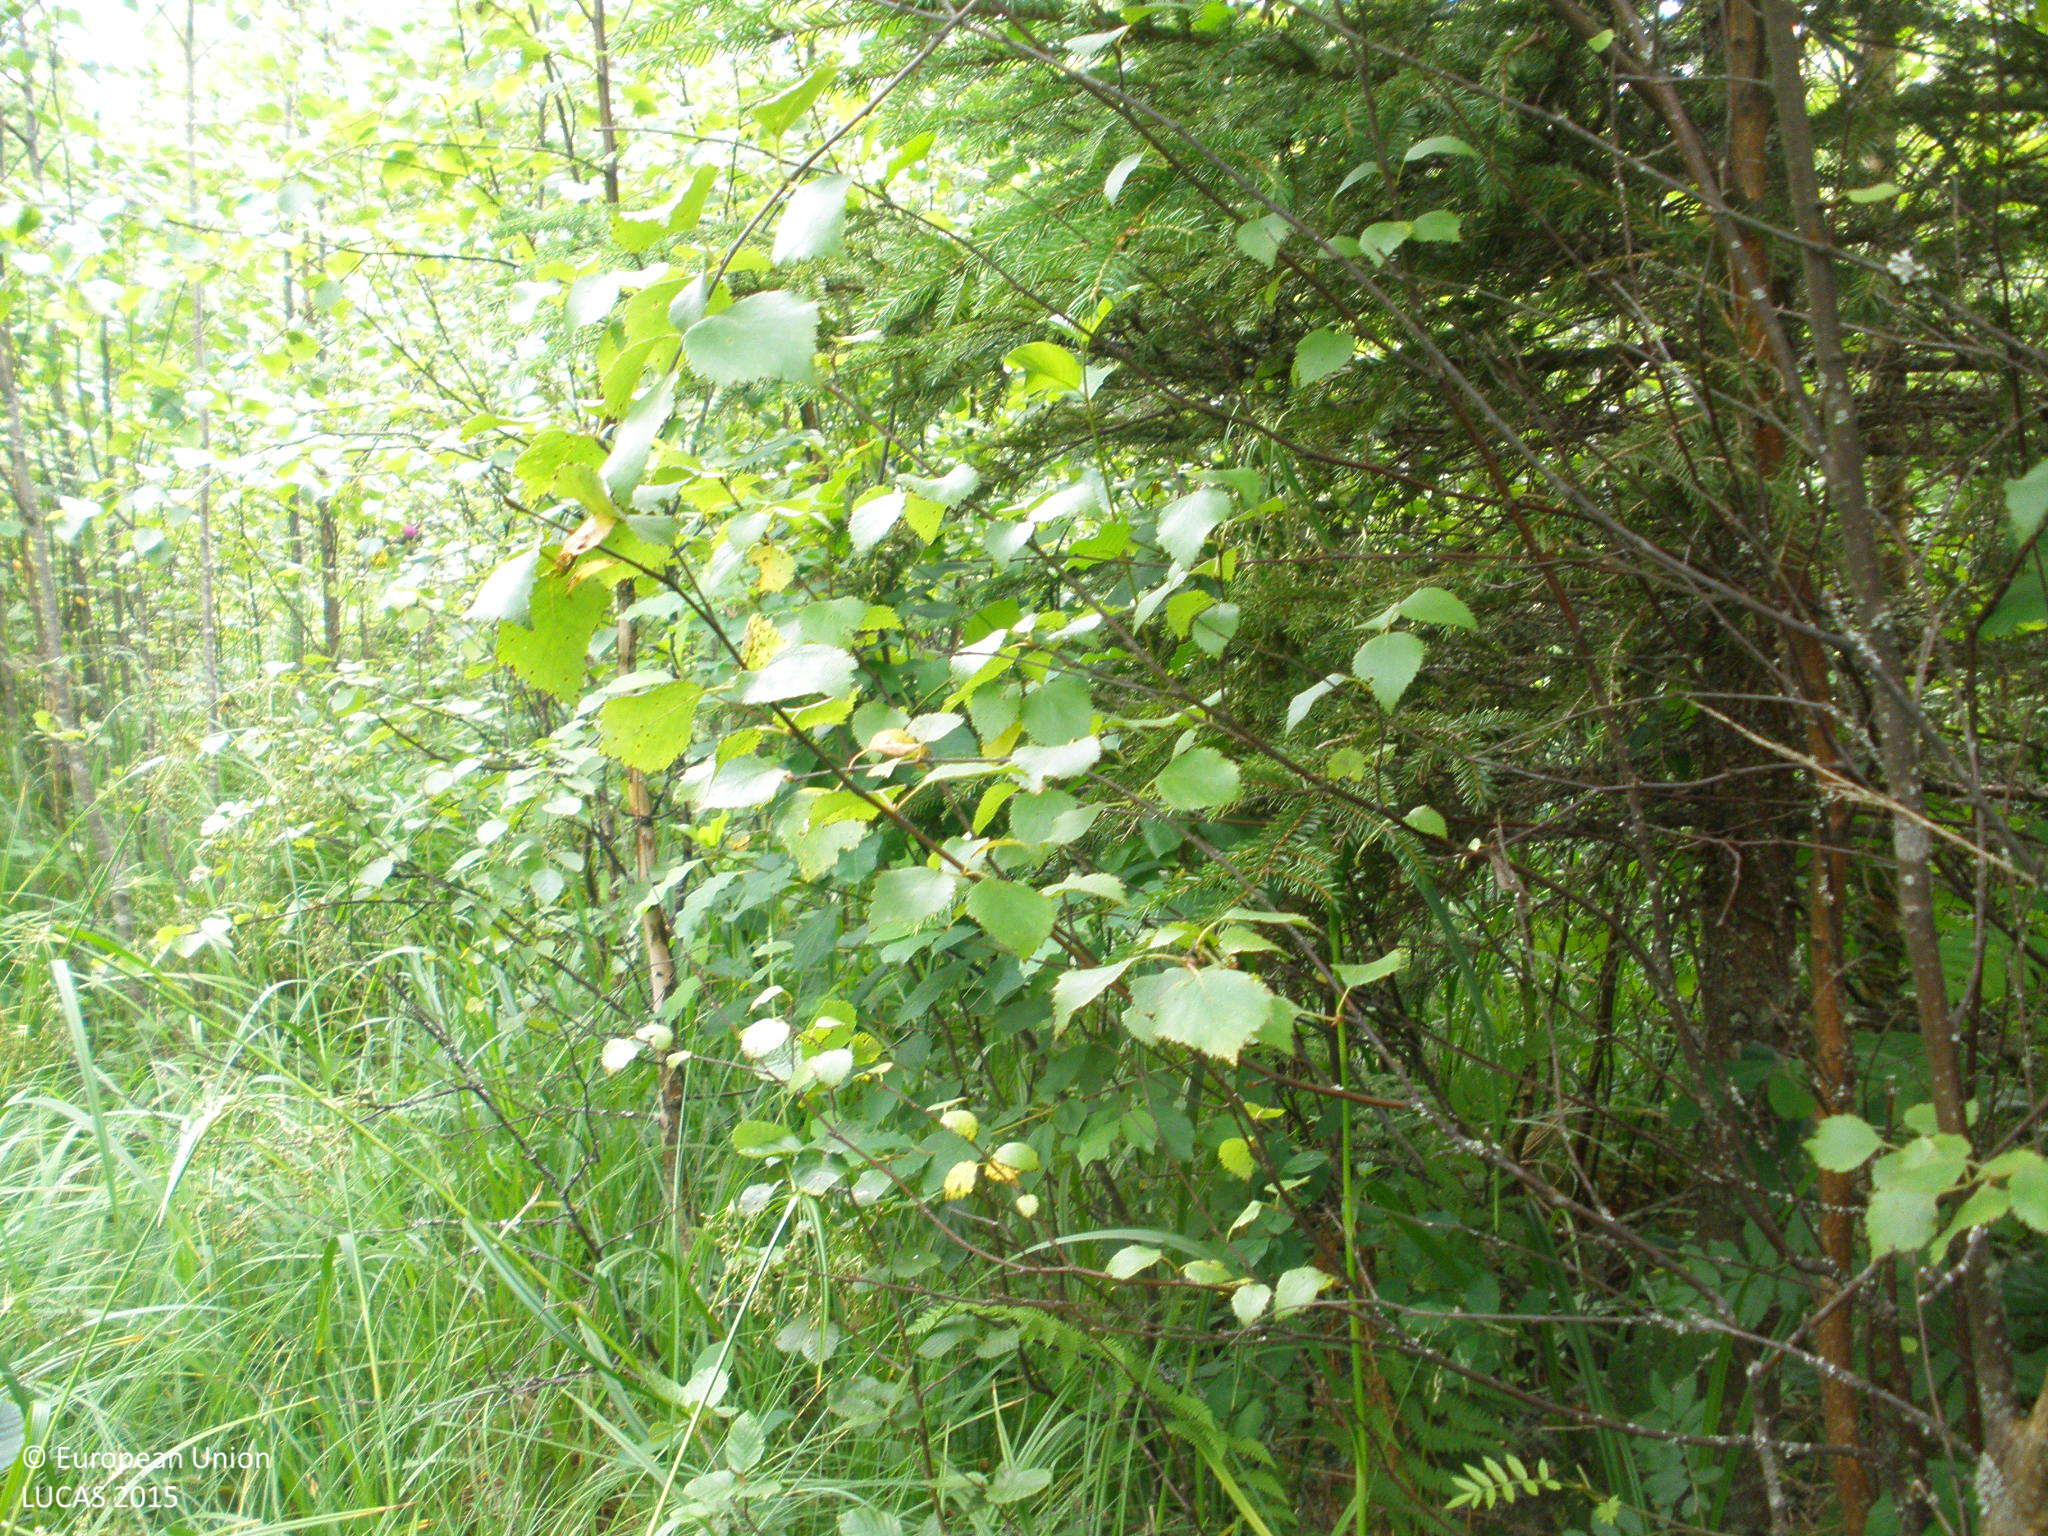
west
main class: Woodland
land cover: Broadleaved woodland
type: boreal forest
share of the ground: > 75 %
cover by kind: broadleaved forest trees 75 %, coniferous forest trees 10 %, herbaceous plants 10 %, shrubs 5 %
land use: Forestry
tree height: < 5 m
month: July
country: FI
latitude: 60.9800
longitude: 24.1961
